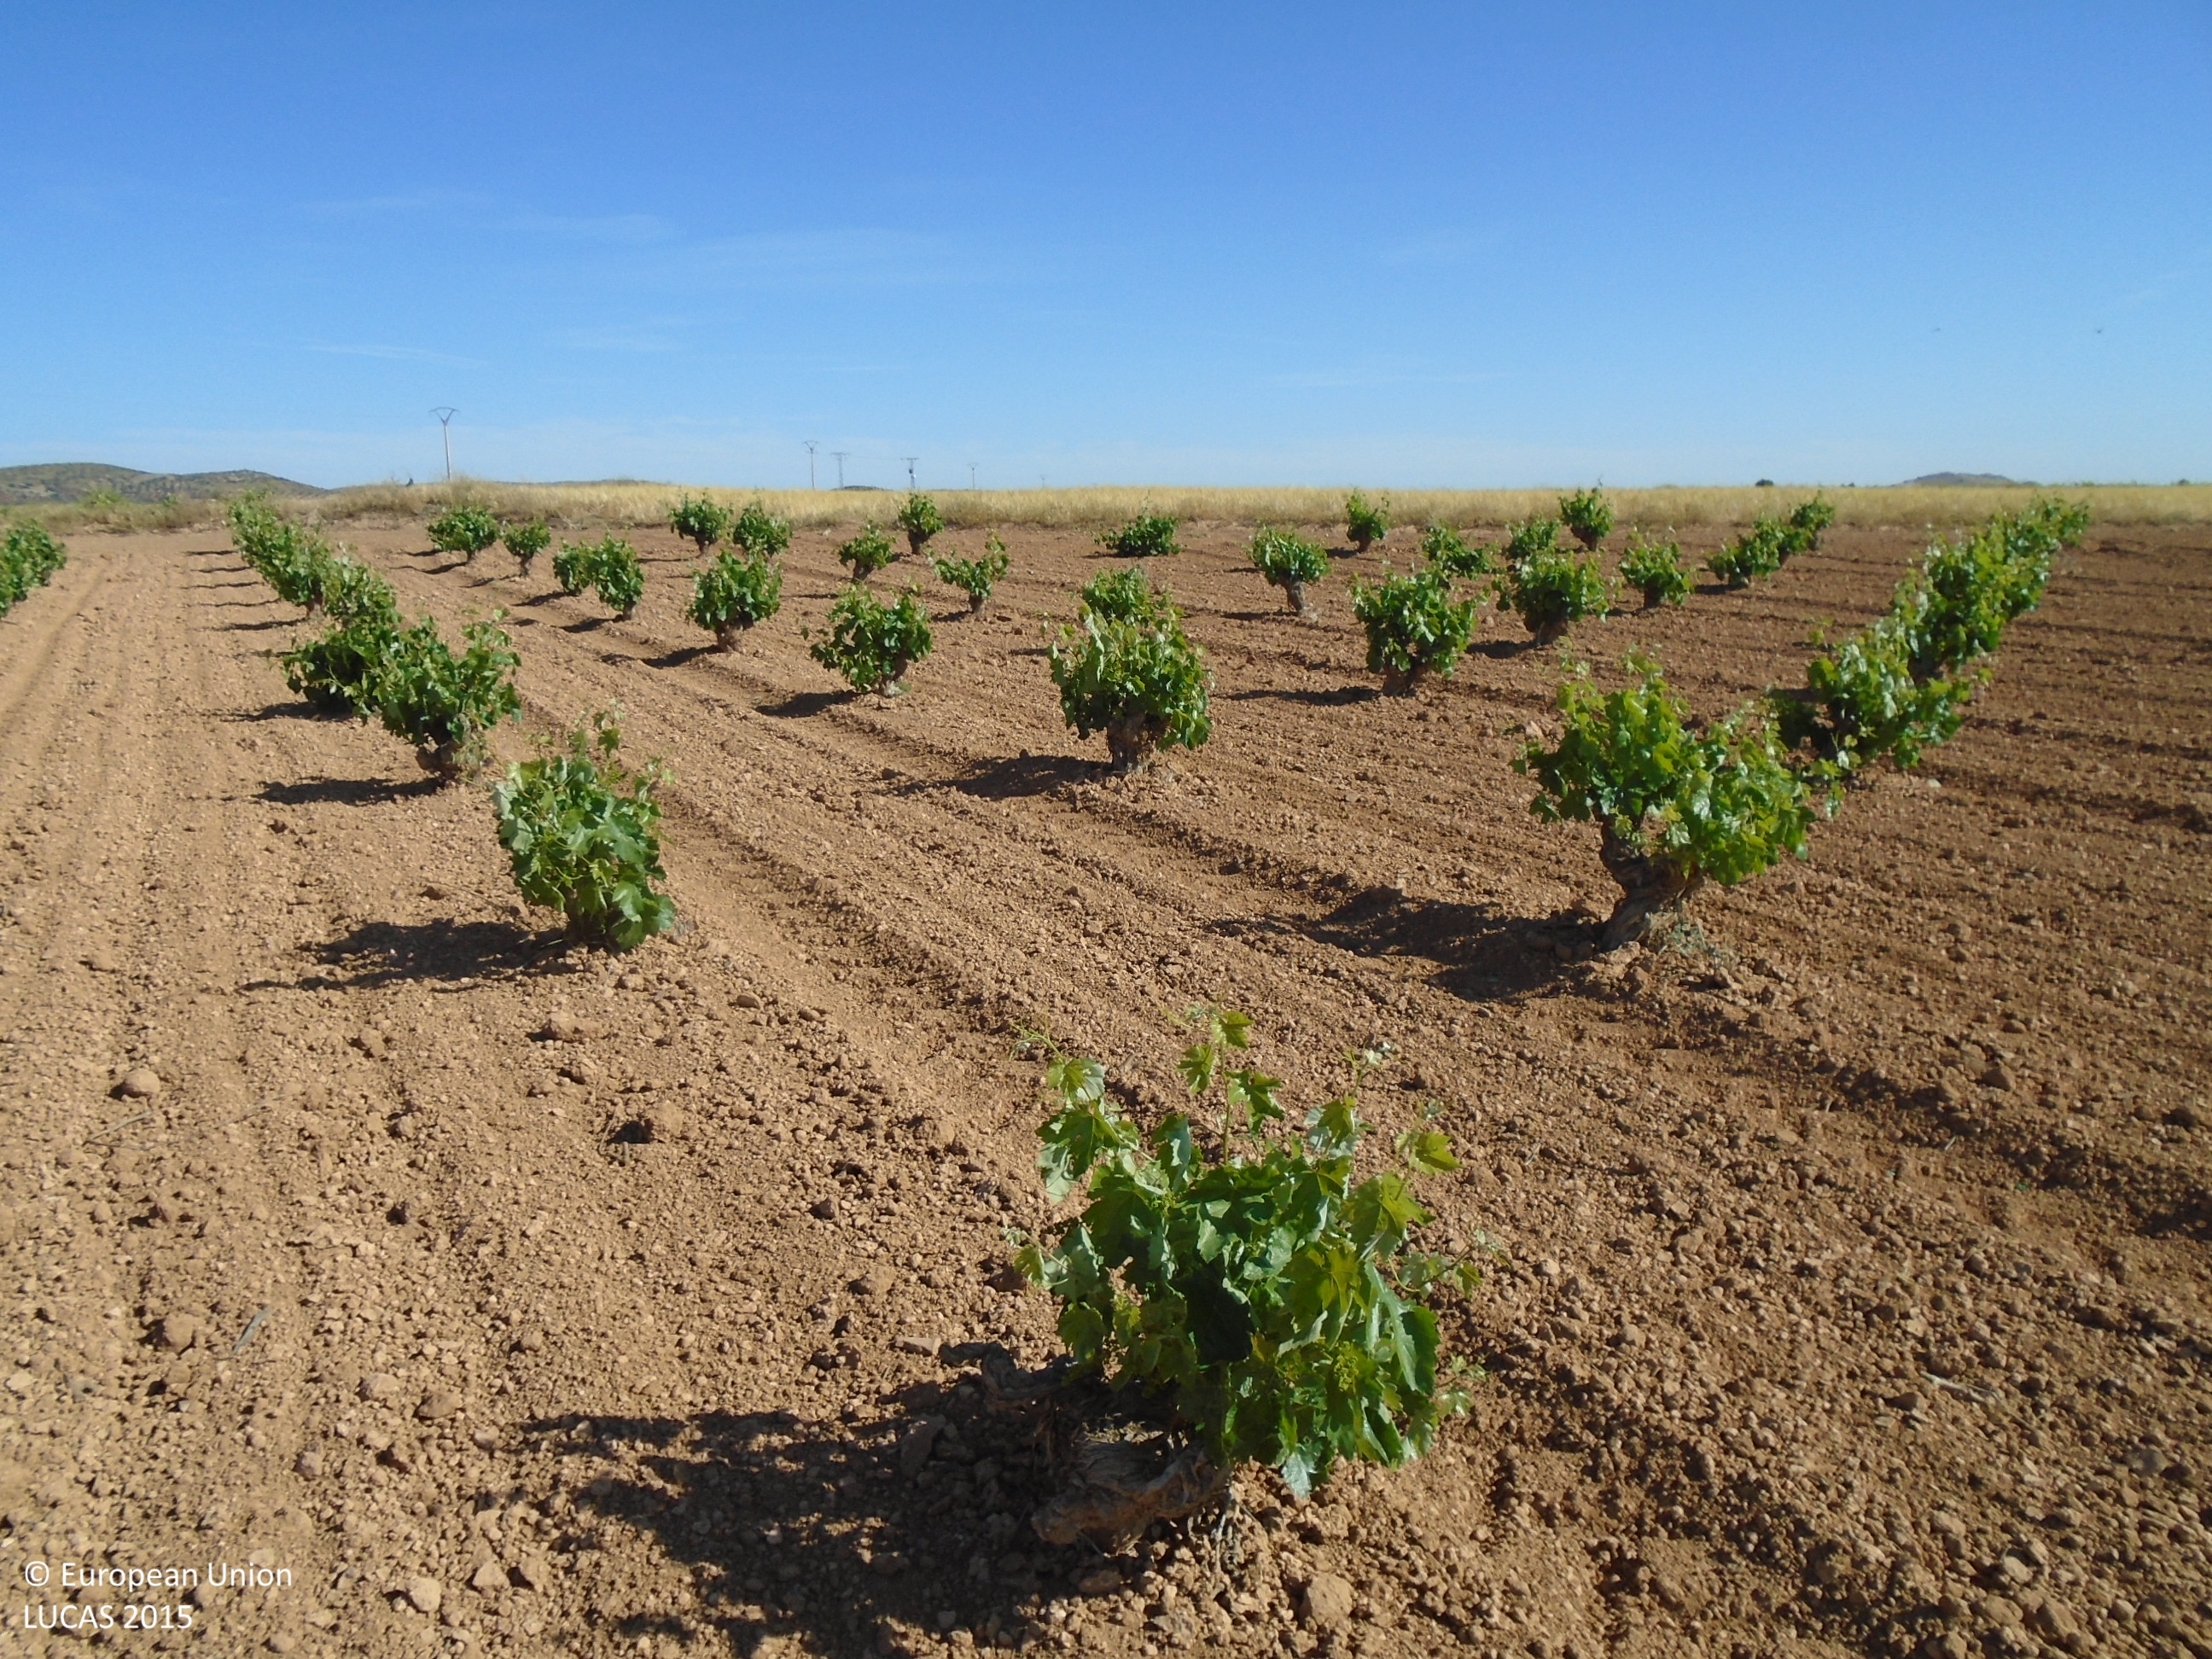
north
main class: Cropland
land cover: Vineyards
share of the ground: 10 - 25 %
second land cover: Other bare soil
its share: > 75 %
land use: Agriculture (excluding fallow land and kitchen gardens)
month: May
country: ES
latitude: 39.4752
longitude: -3.6366
